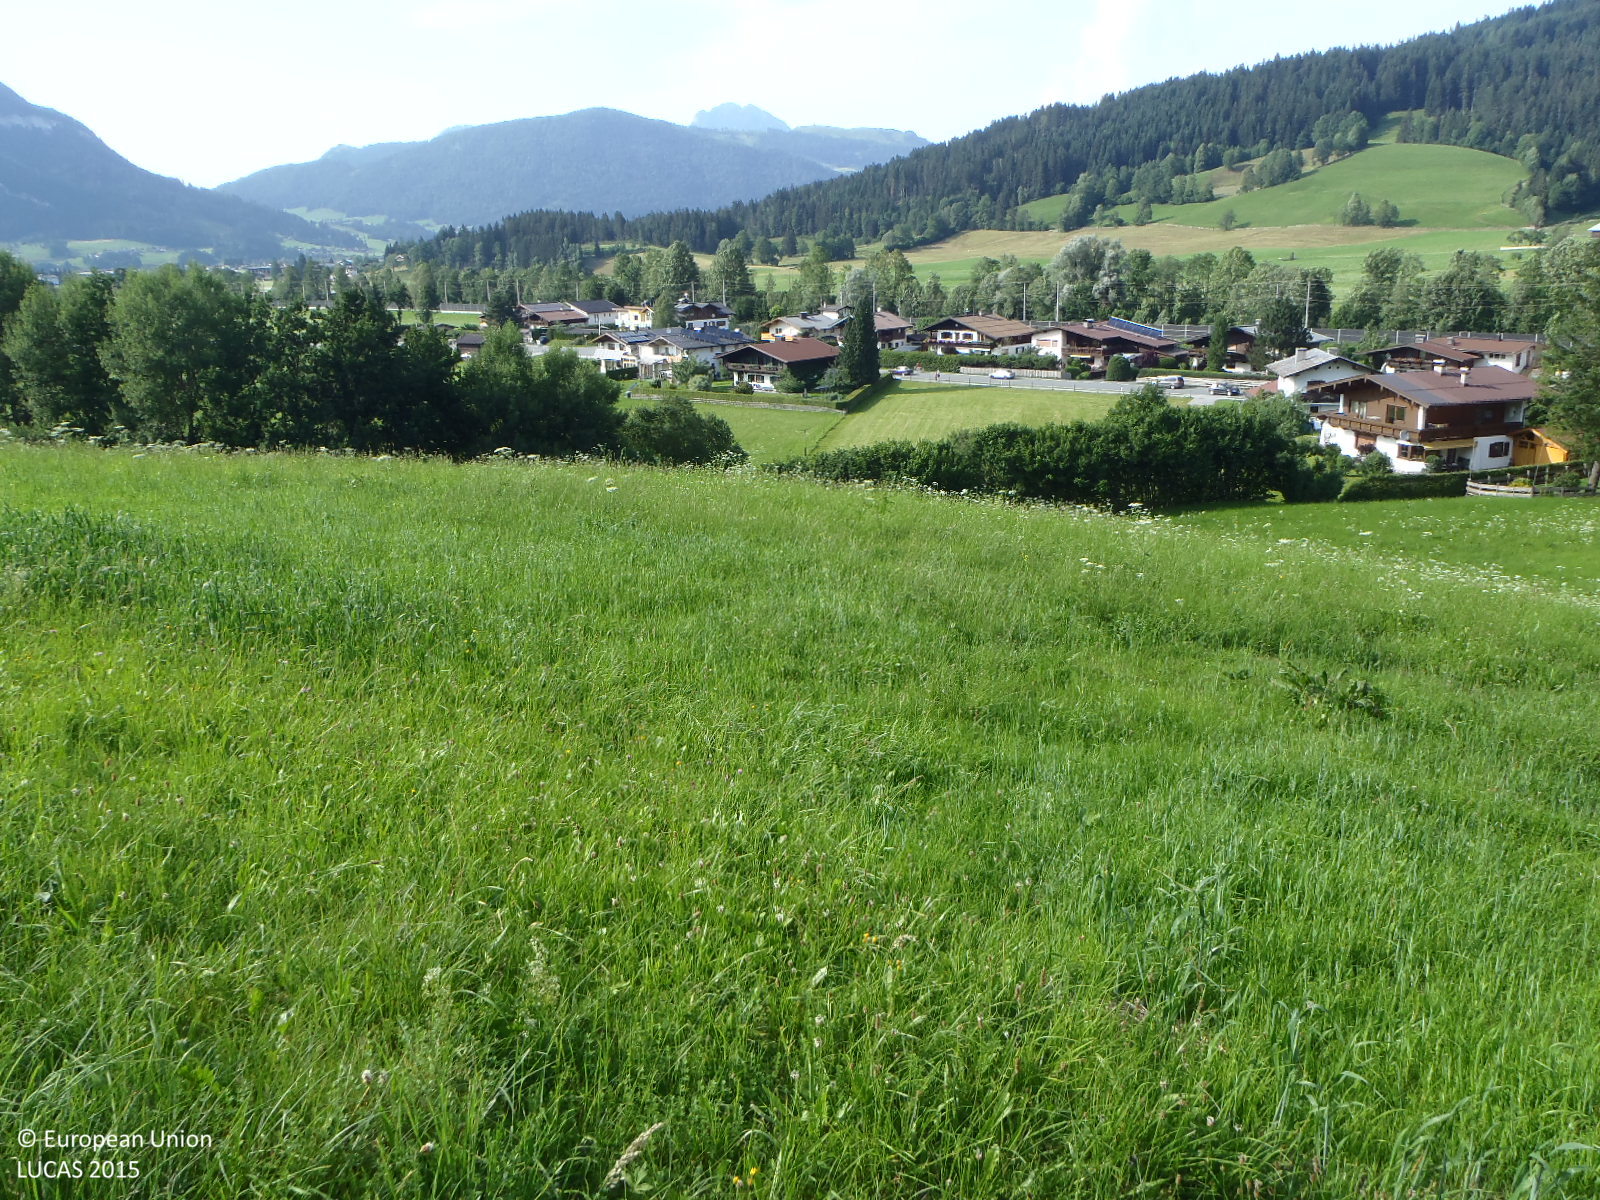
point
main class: Grassland
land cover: Grassland without tree/shrub cover
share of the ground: > 75 %
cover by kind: herbaceous plants 100 %
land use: Agriculture (excluding fallow land and kitchen gardens)
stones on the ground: < 10 %
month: July
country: AT
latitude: 47.5120
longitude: 12.4548
